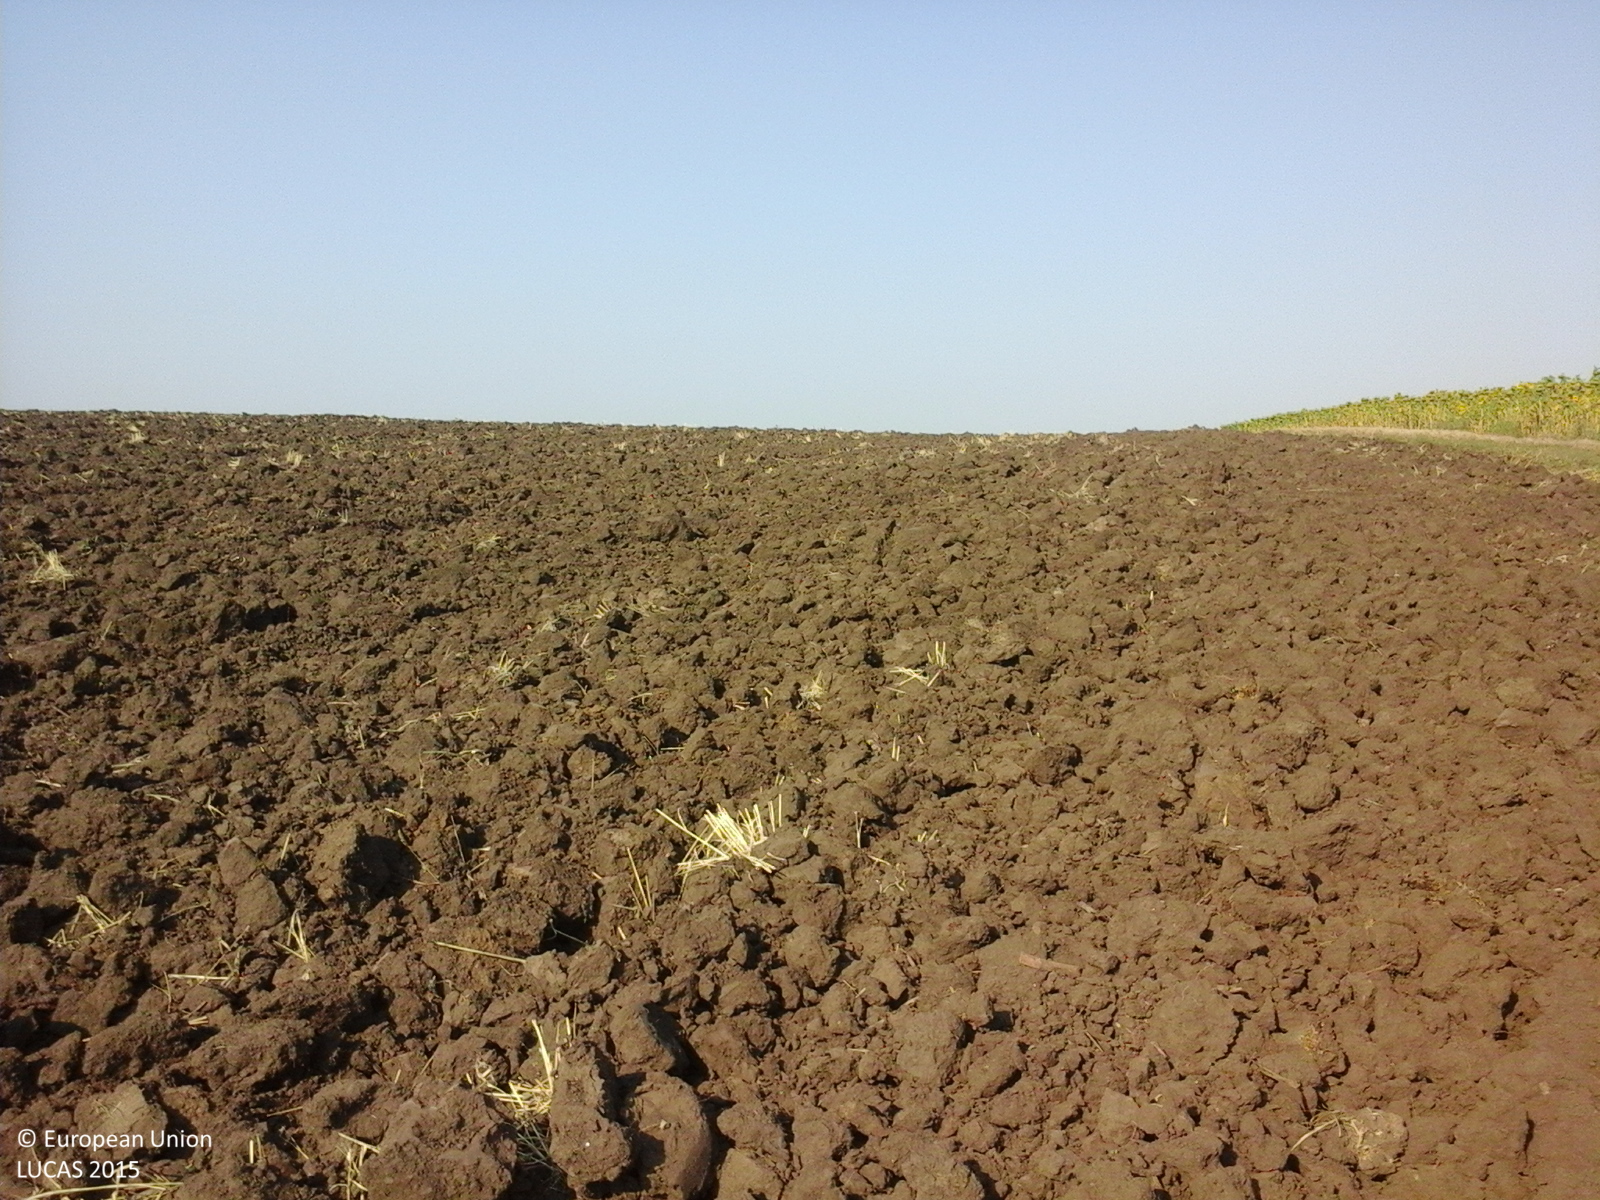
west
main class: Cropland
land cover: Common wheat
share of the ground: < 10 %
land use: Agriculture (excluding fallow land and kitchen gardens)
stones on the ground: < 10 %
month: July
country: RO
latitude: 45.6784
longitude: 27.9766
